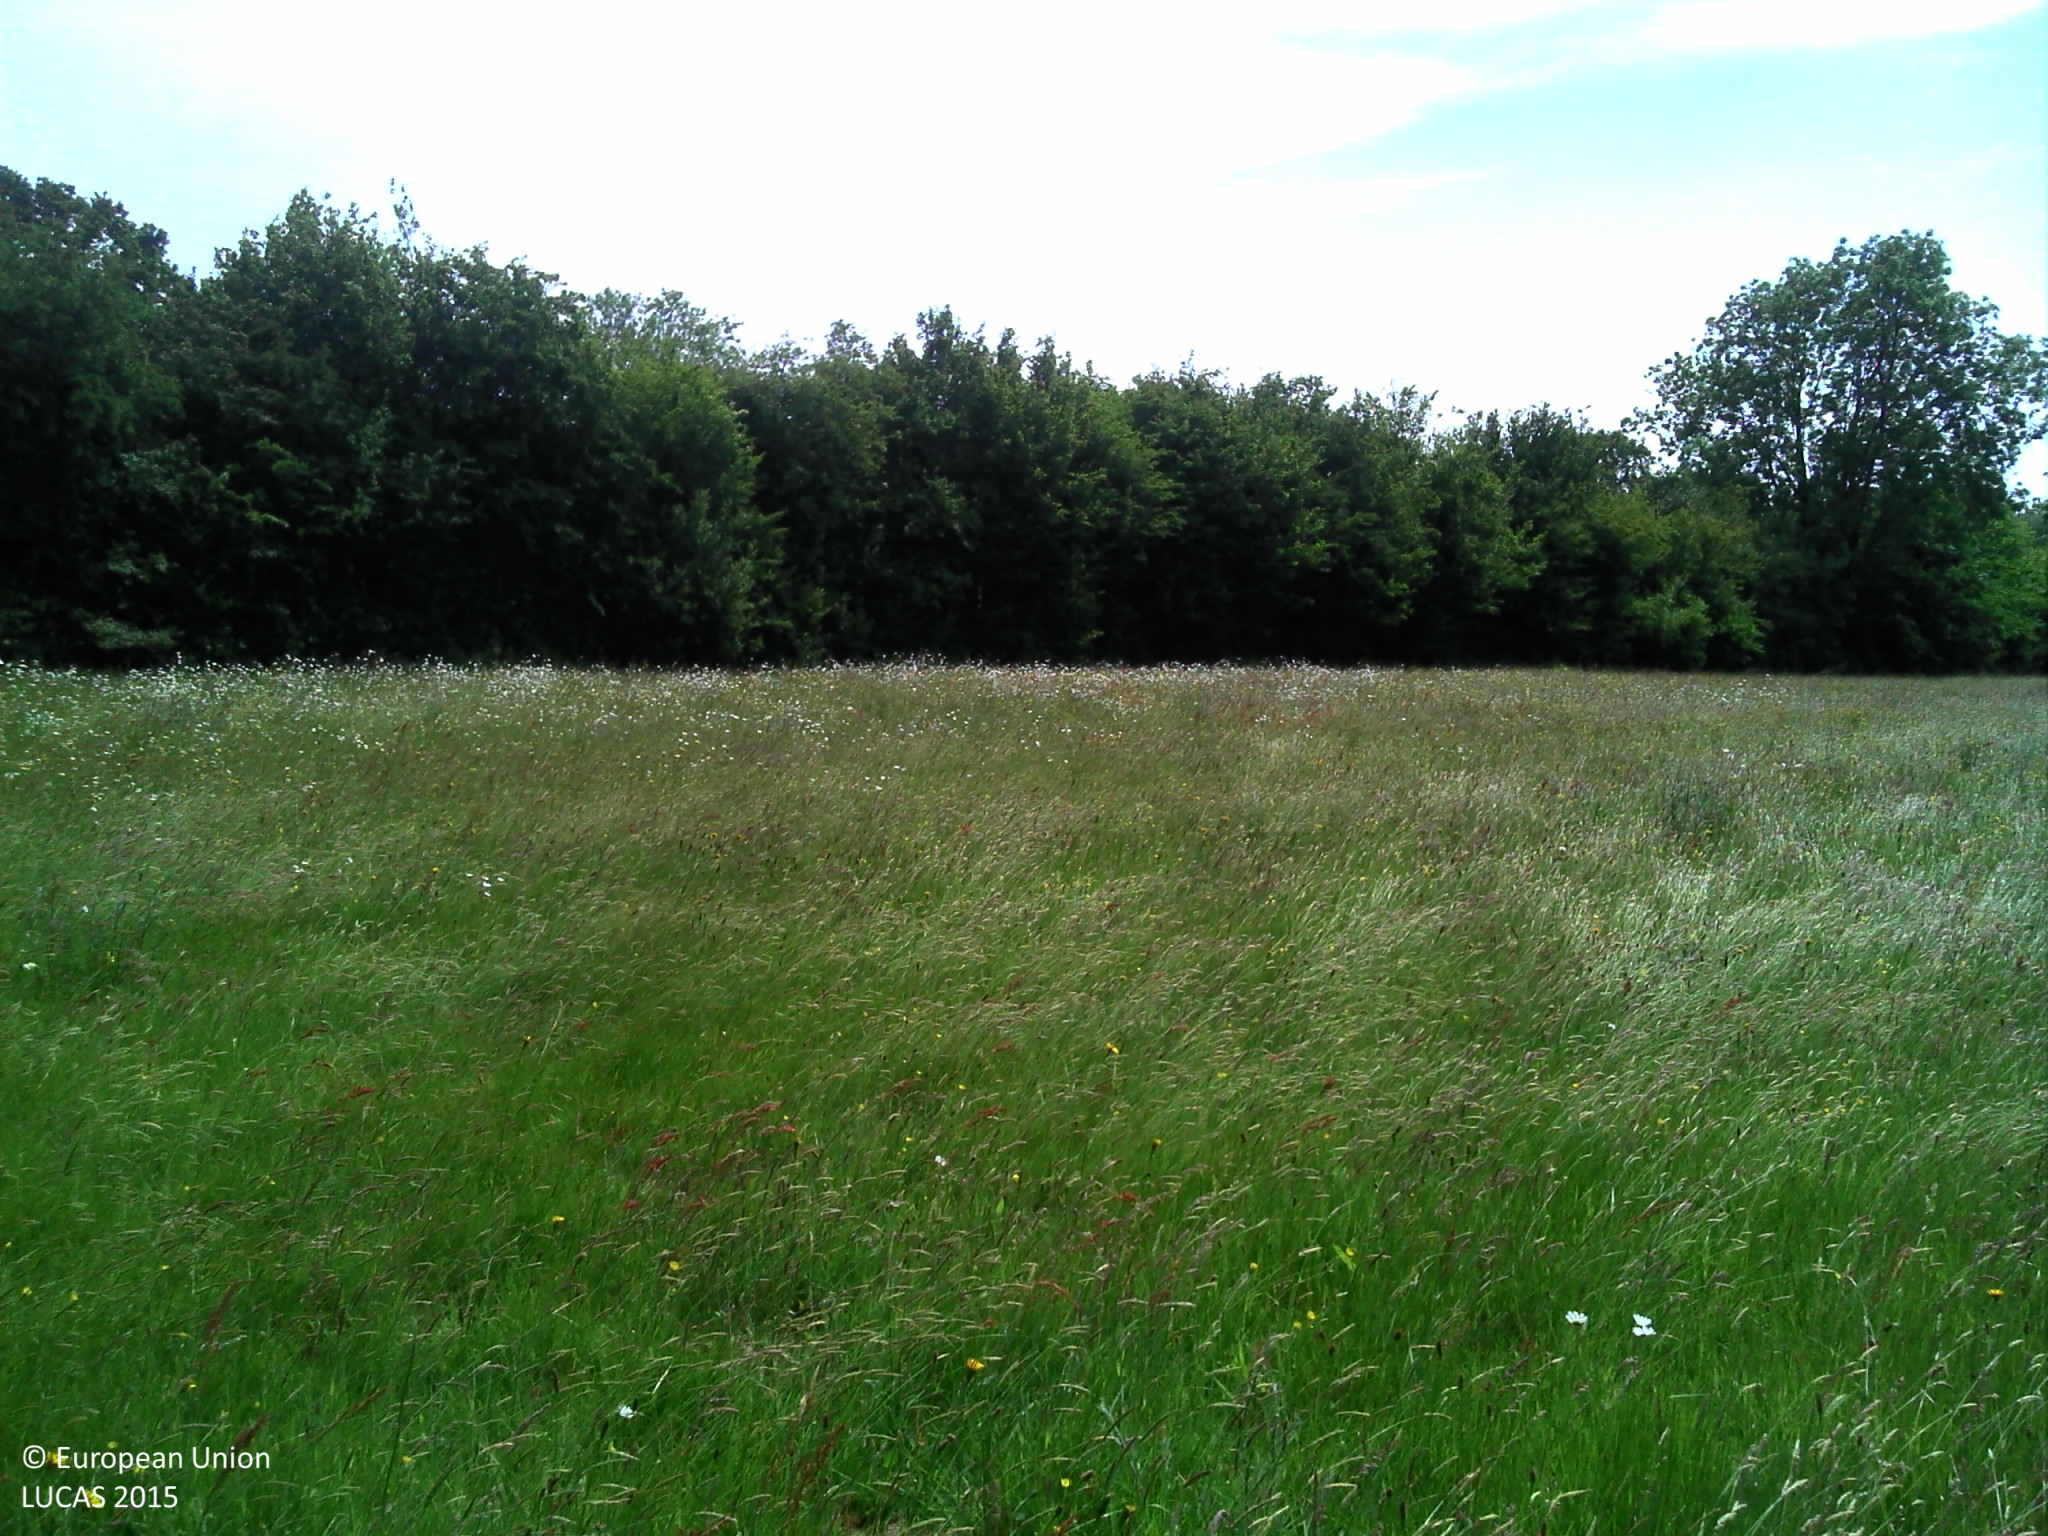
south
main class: Grassland
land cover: Grassland without tree/shrub cover
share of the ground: > 75 %
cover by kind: herbaceous plants 100 %
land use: Agriculture (excluding fallow land and kitchen gardens)
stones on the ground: < 10 %
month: June
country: FR
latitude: 49.4945
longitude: -1.4669
